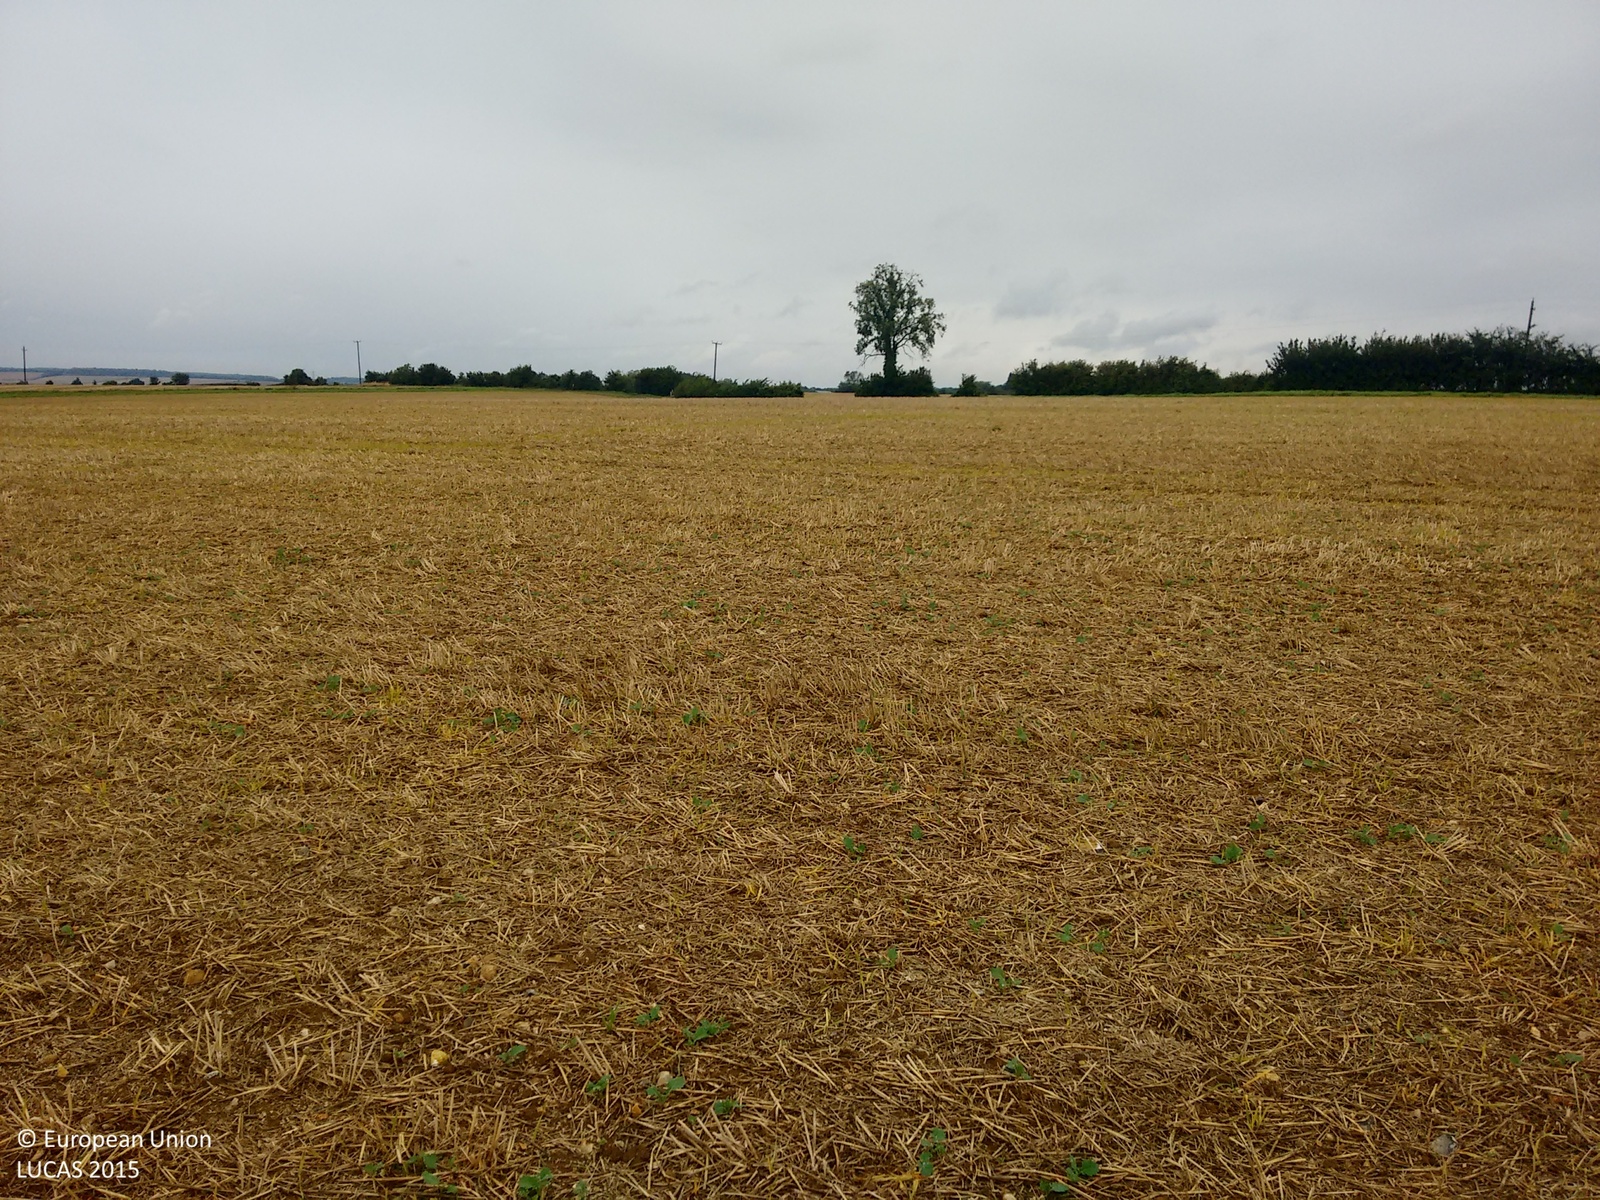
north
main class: Cropland
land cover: Common wheat
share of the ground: 50 - 75 %
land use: Agriculture (excluding fallow land and kitchen gardens)
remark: Harvested field
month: September
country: GB
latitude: 51.9736
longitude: 0.2308
